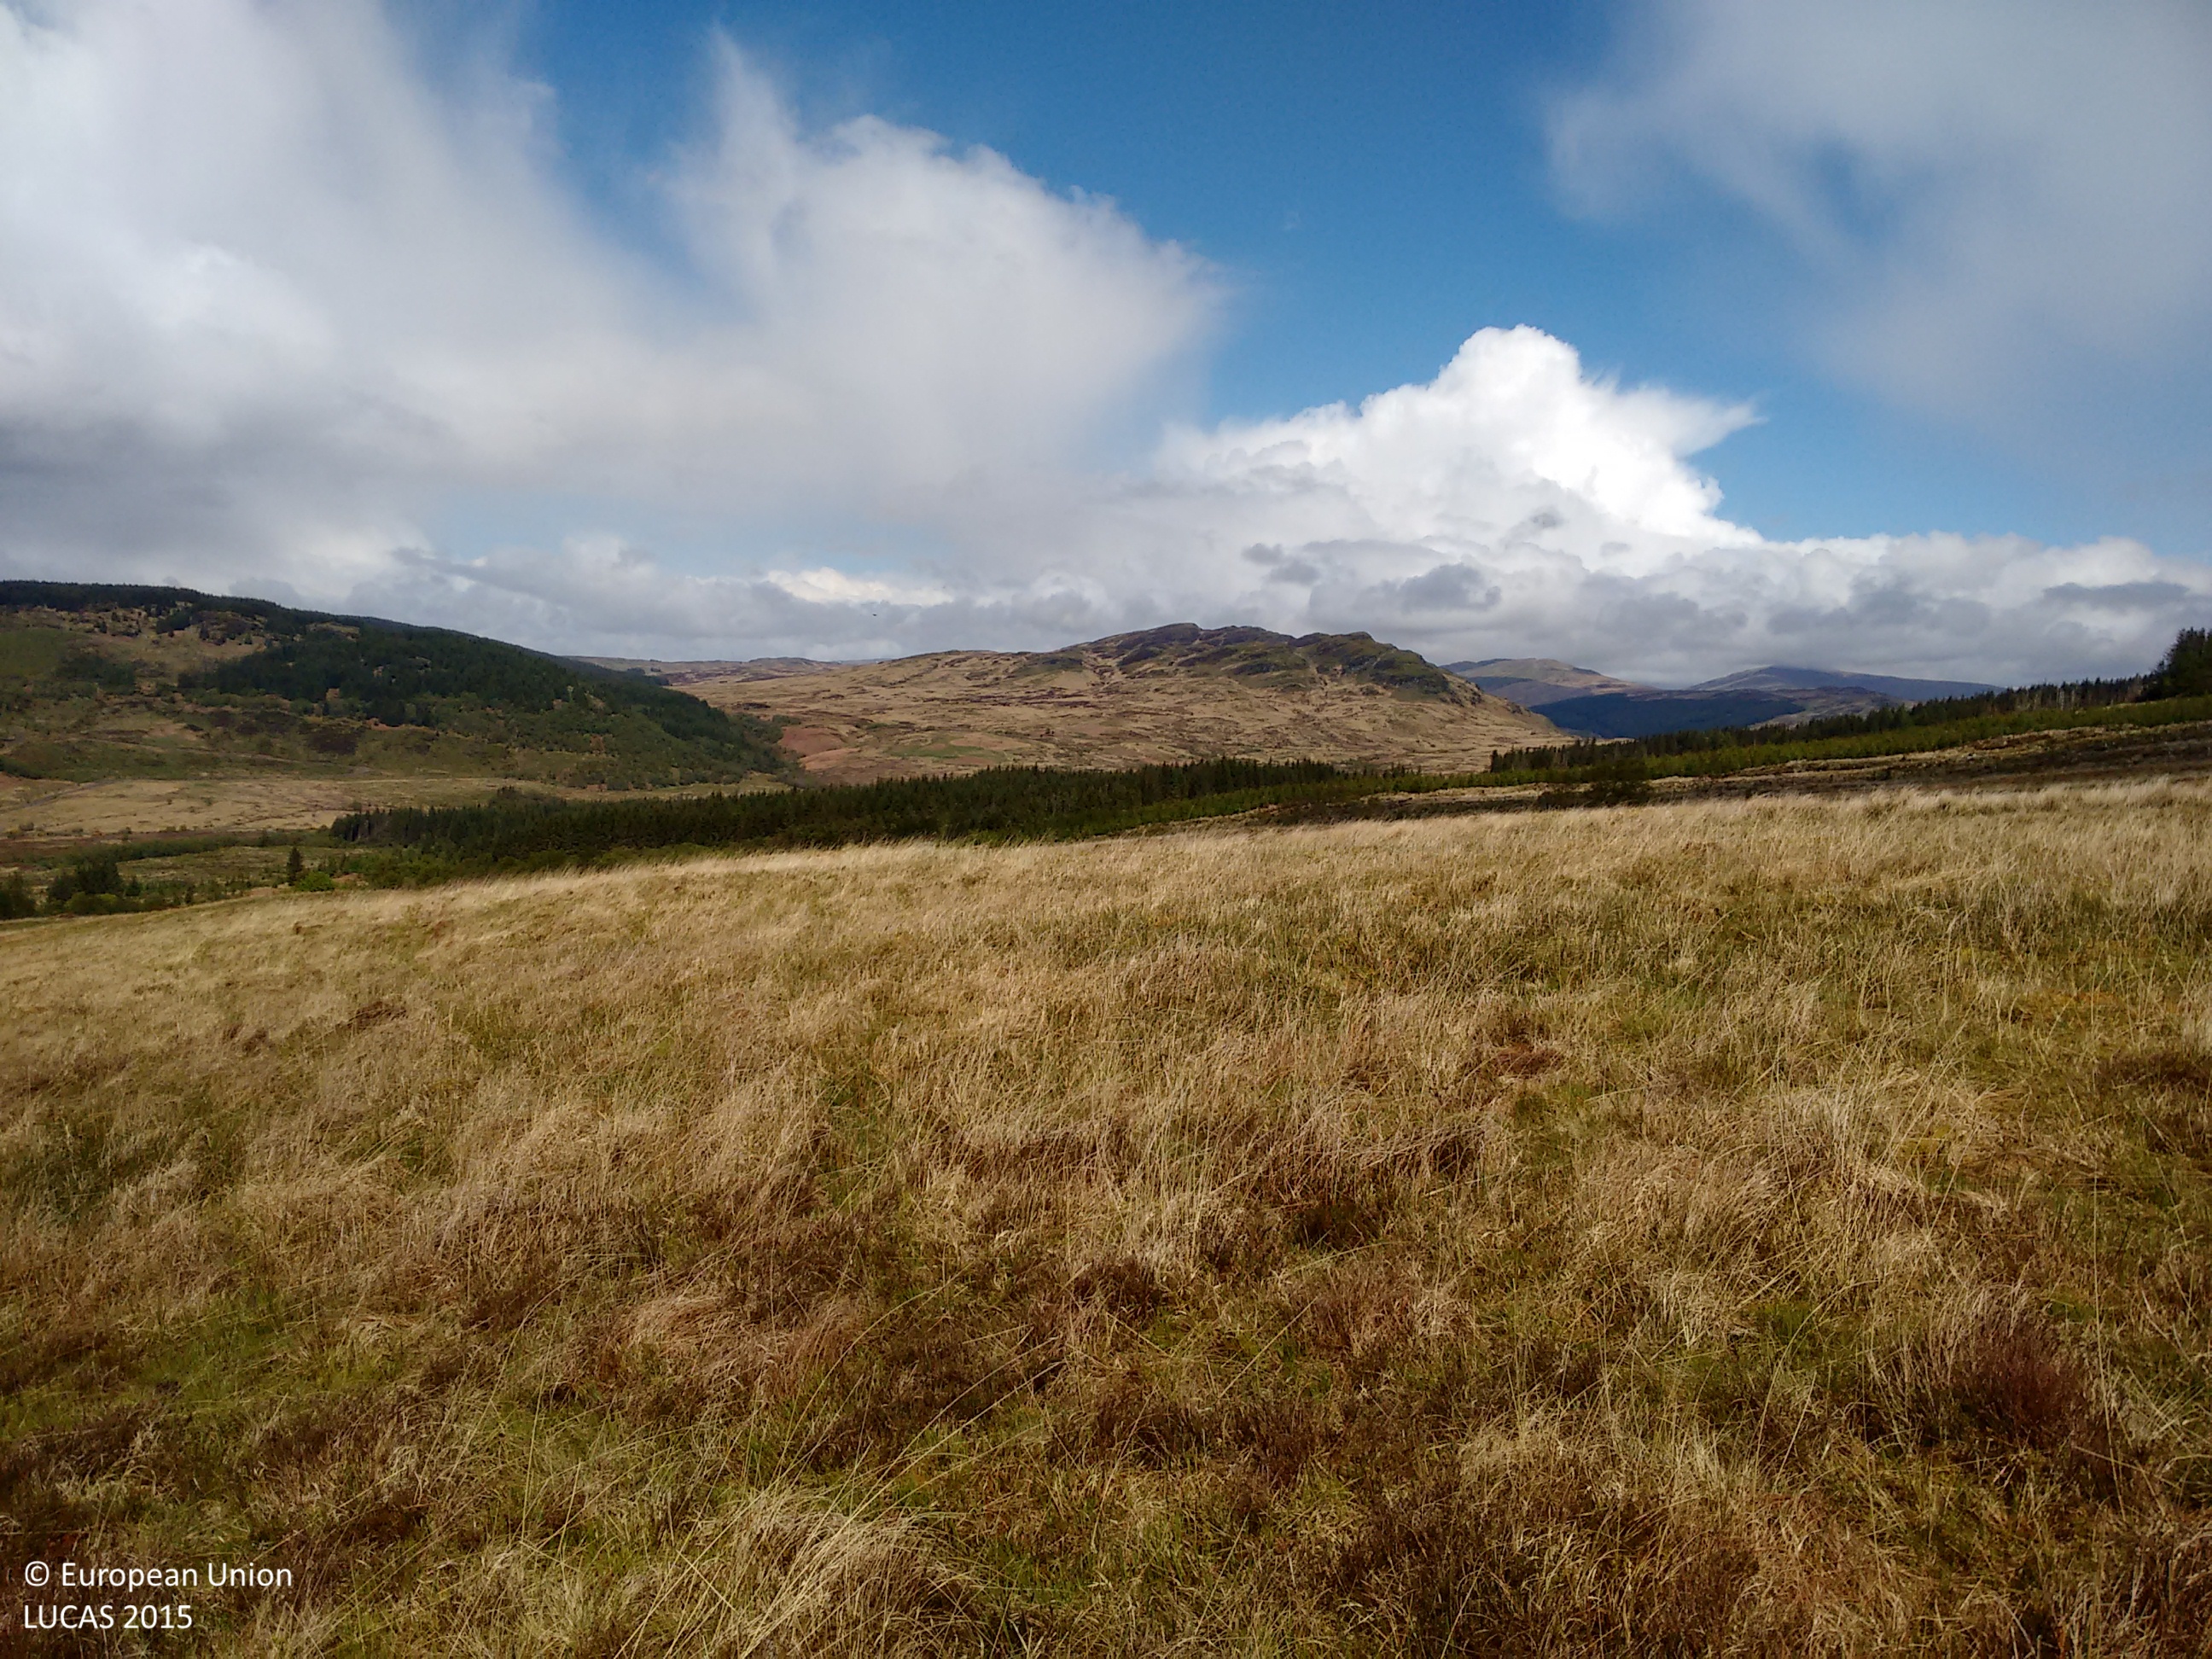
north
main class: Grassland
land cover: Grassland without tree/shrub cover
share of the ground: > 75 %
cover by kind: herbaceous plants 100 %
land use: Agriculture (excluding fallow land and kitchen gardens)
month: May
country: GB
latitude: 55.9759
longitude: -5.1612
